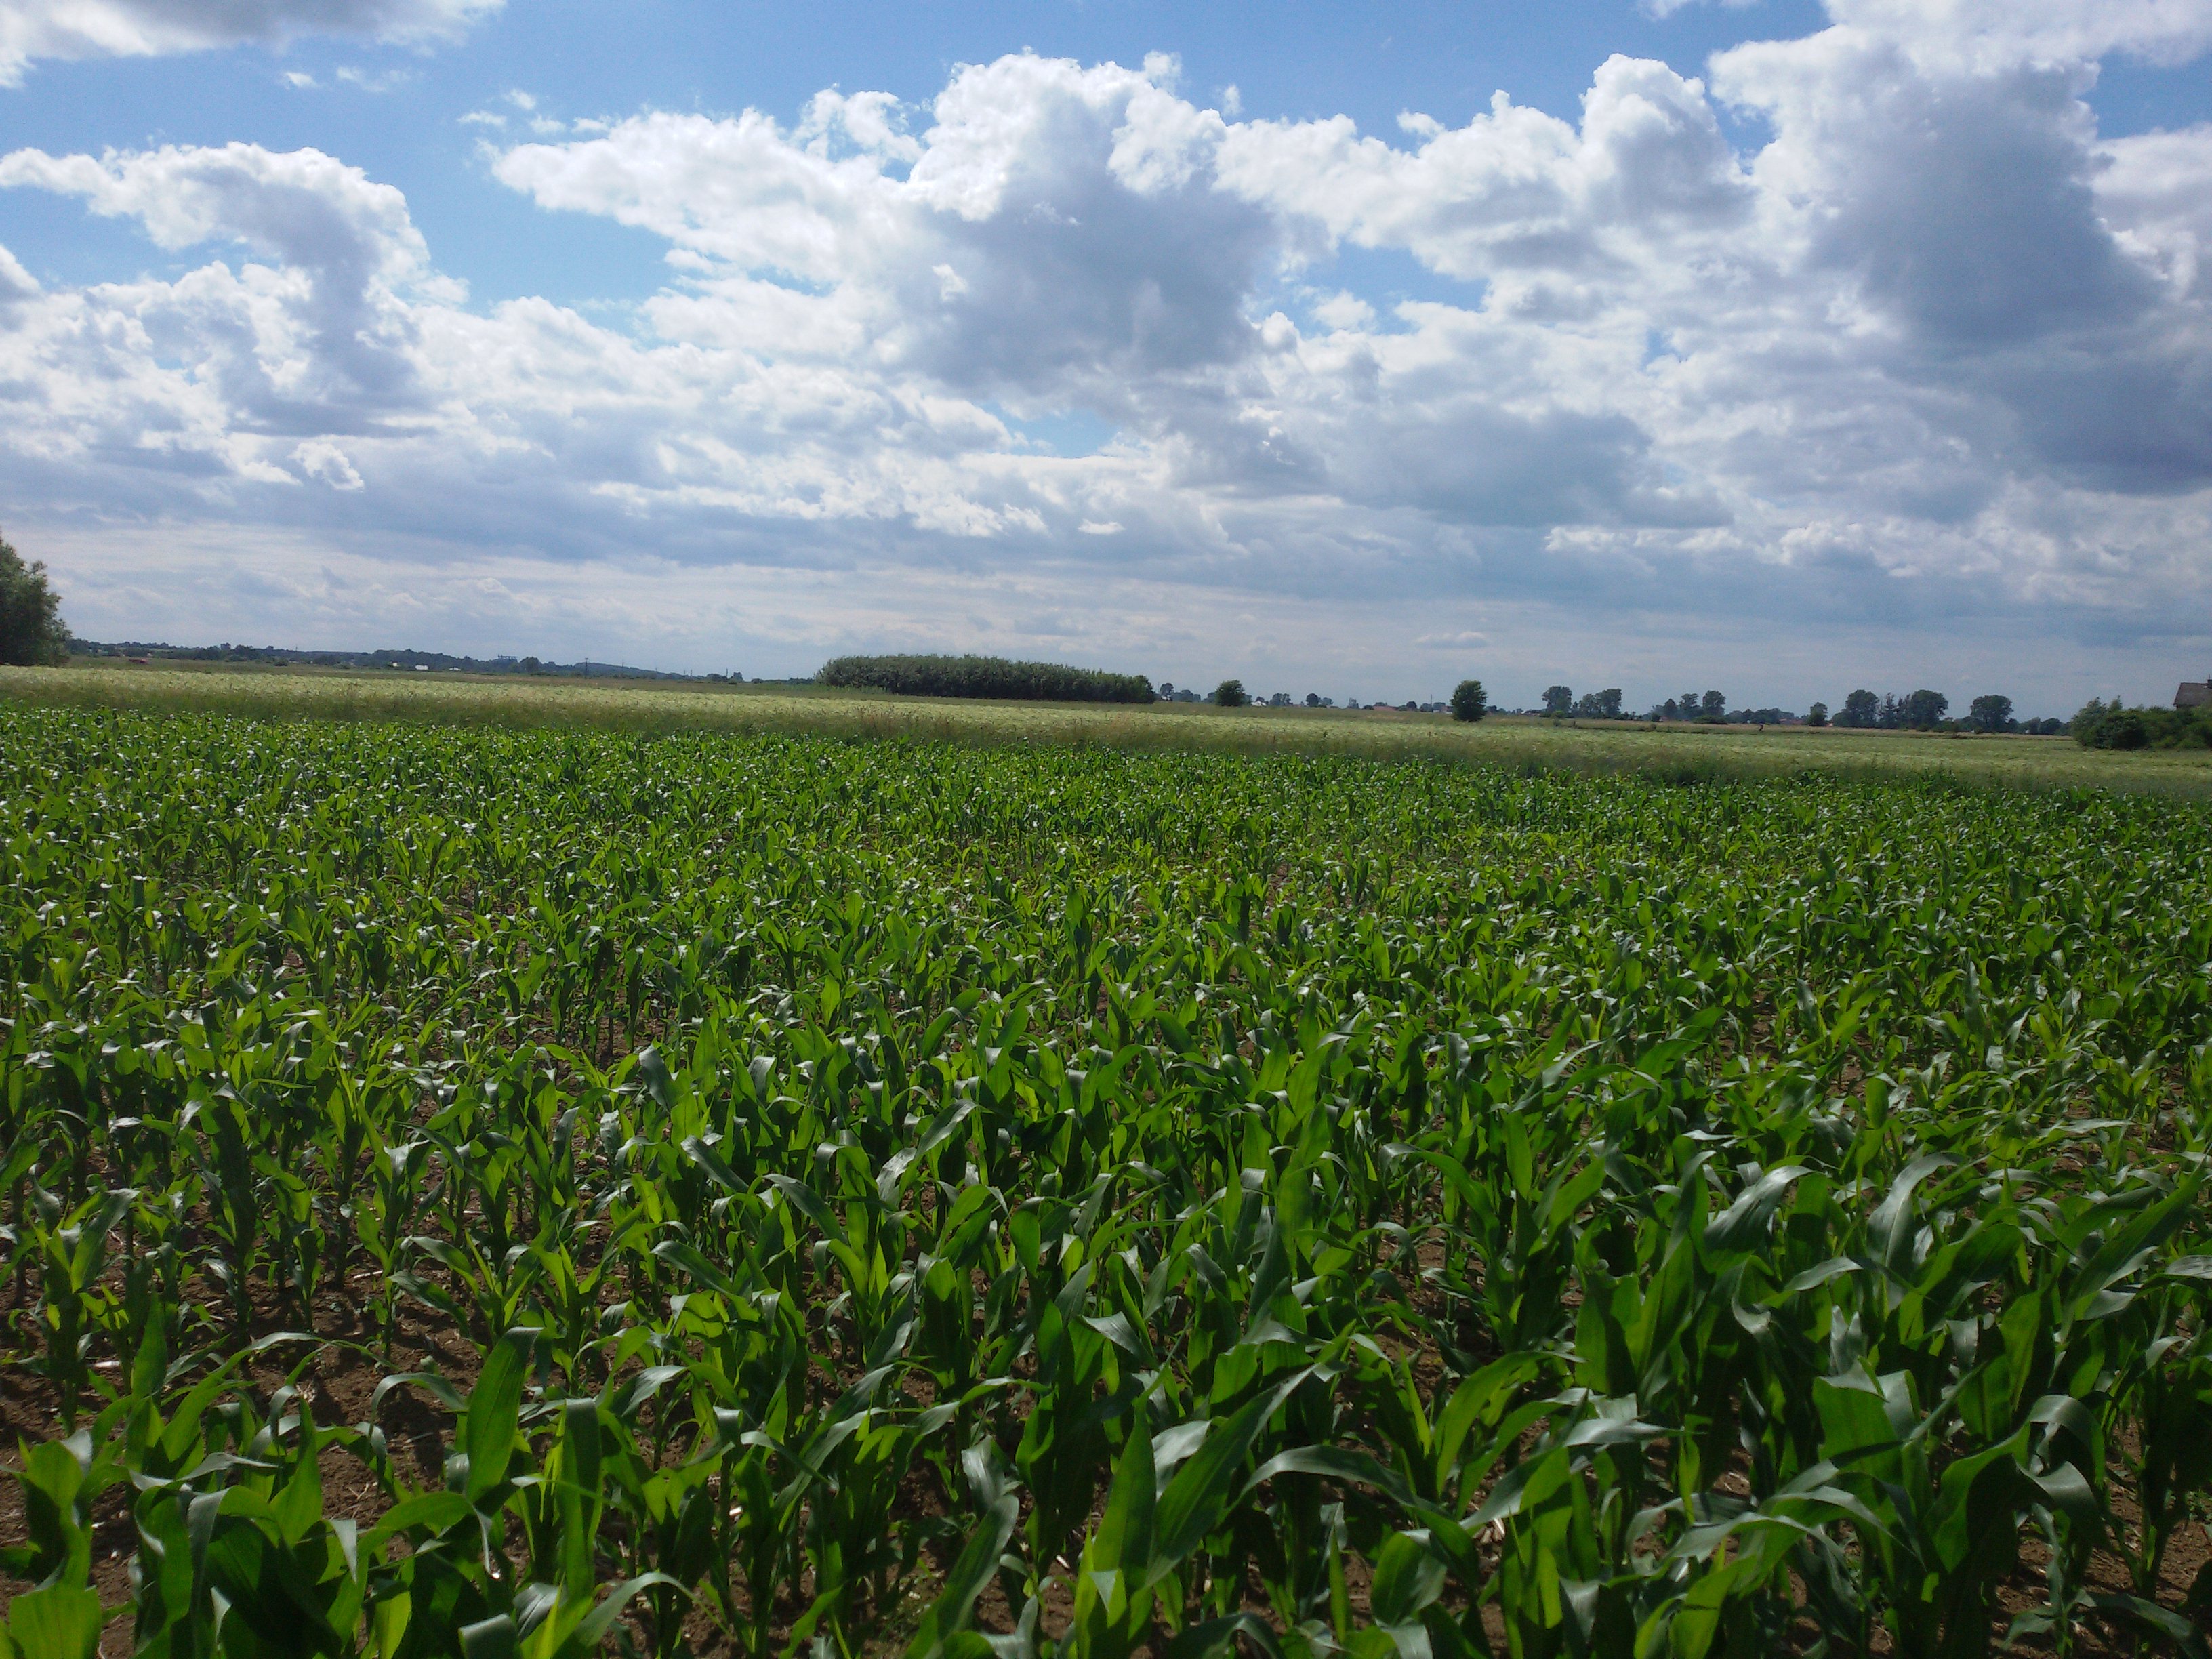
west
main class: Cropland
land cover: Maize
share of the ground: 50 - 75 %
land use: Agriculture (excluding fallow land and kitchen gardens)
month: June
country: PL
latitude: 50.0920
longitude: 22.3495
